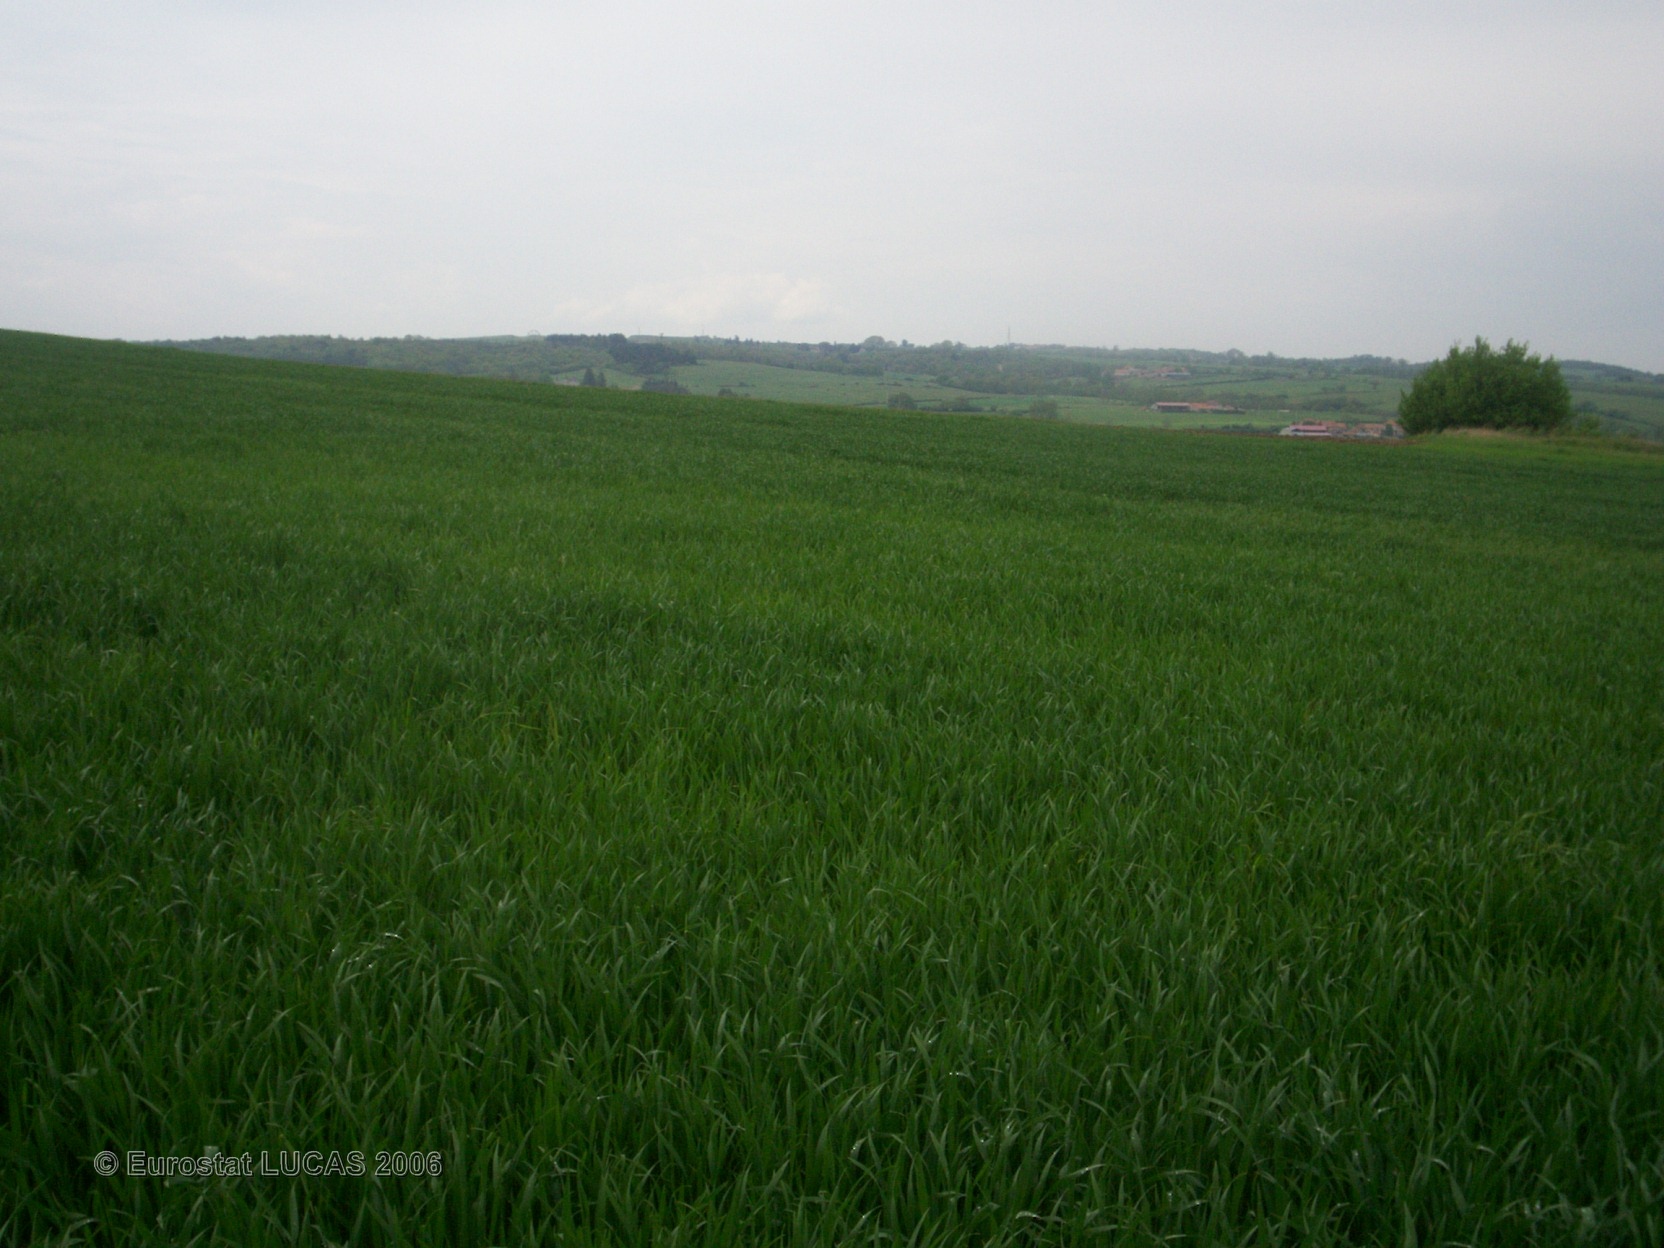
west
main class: Cropland
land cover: Common wheat
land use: Agriculture (excluding fallow land and kitchen gardens)
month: May
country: FR
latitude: 46.0599
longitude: 3.1610
